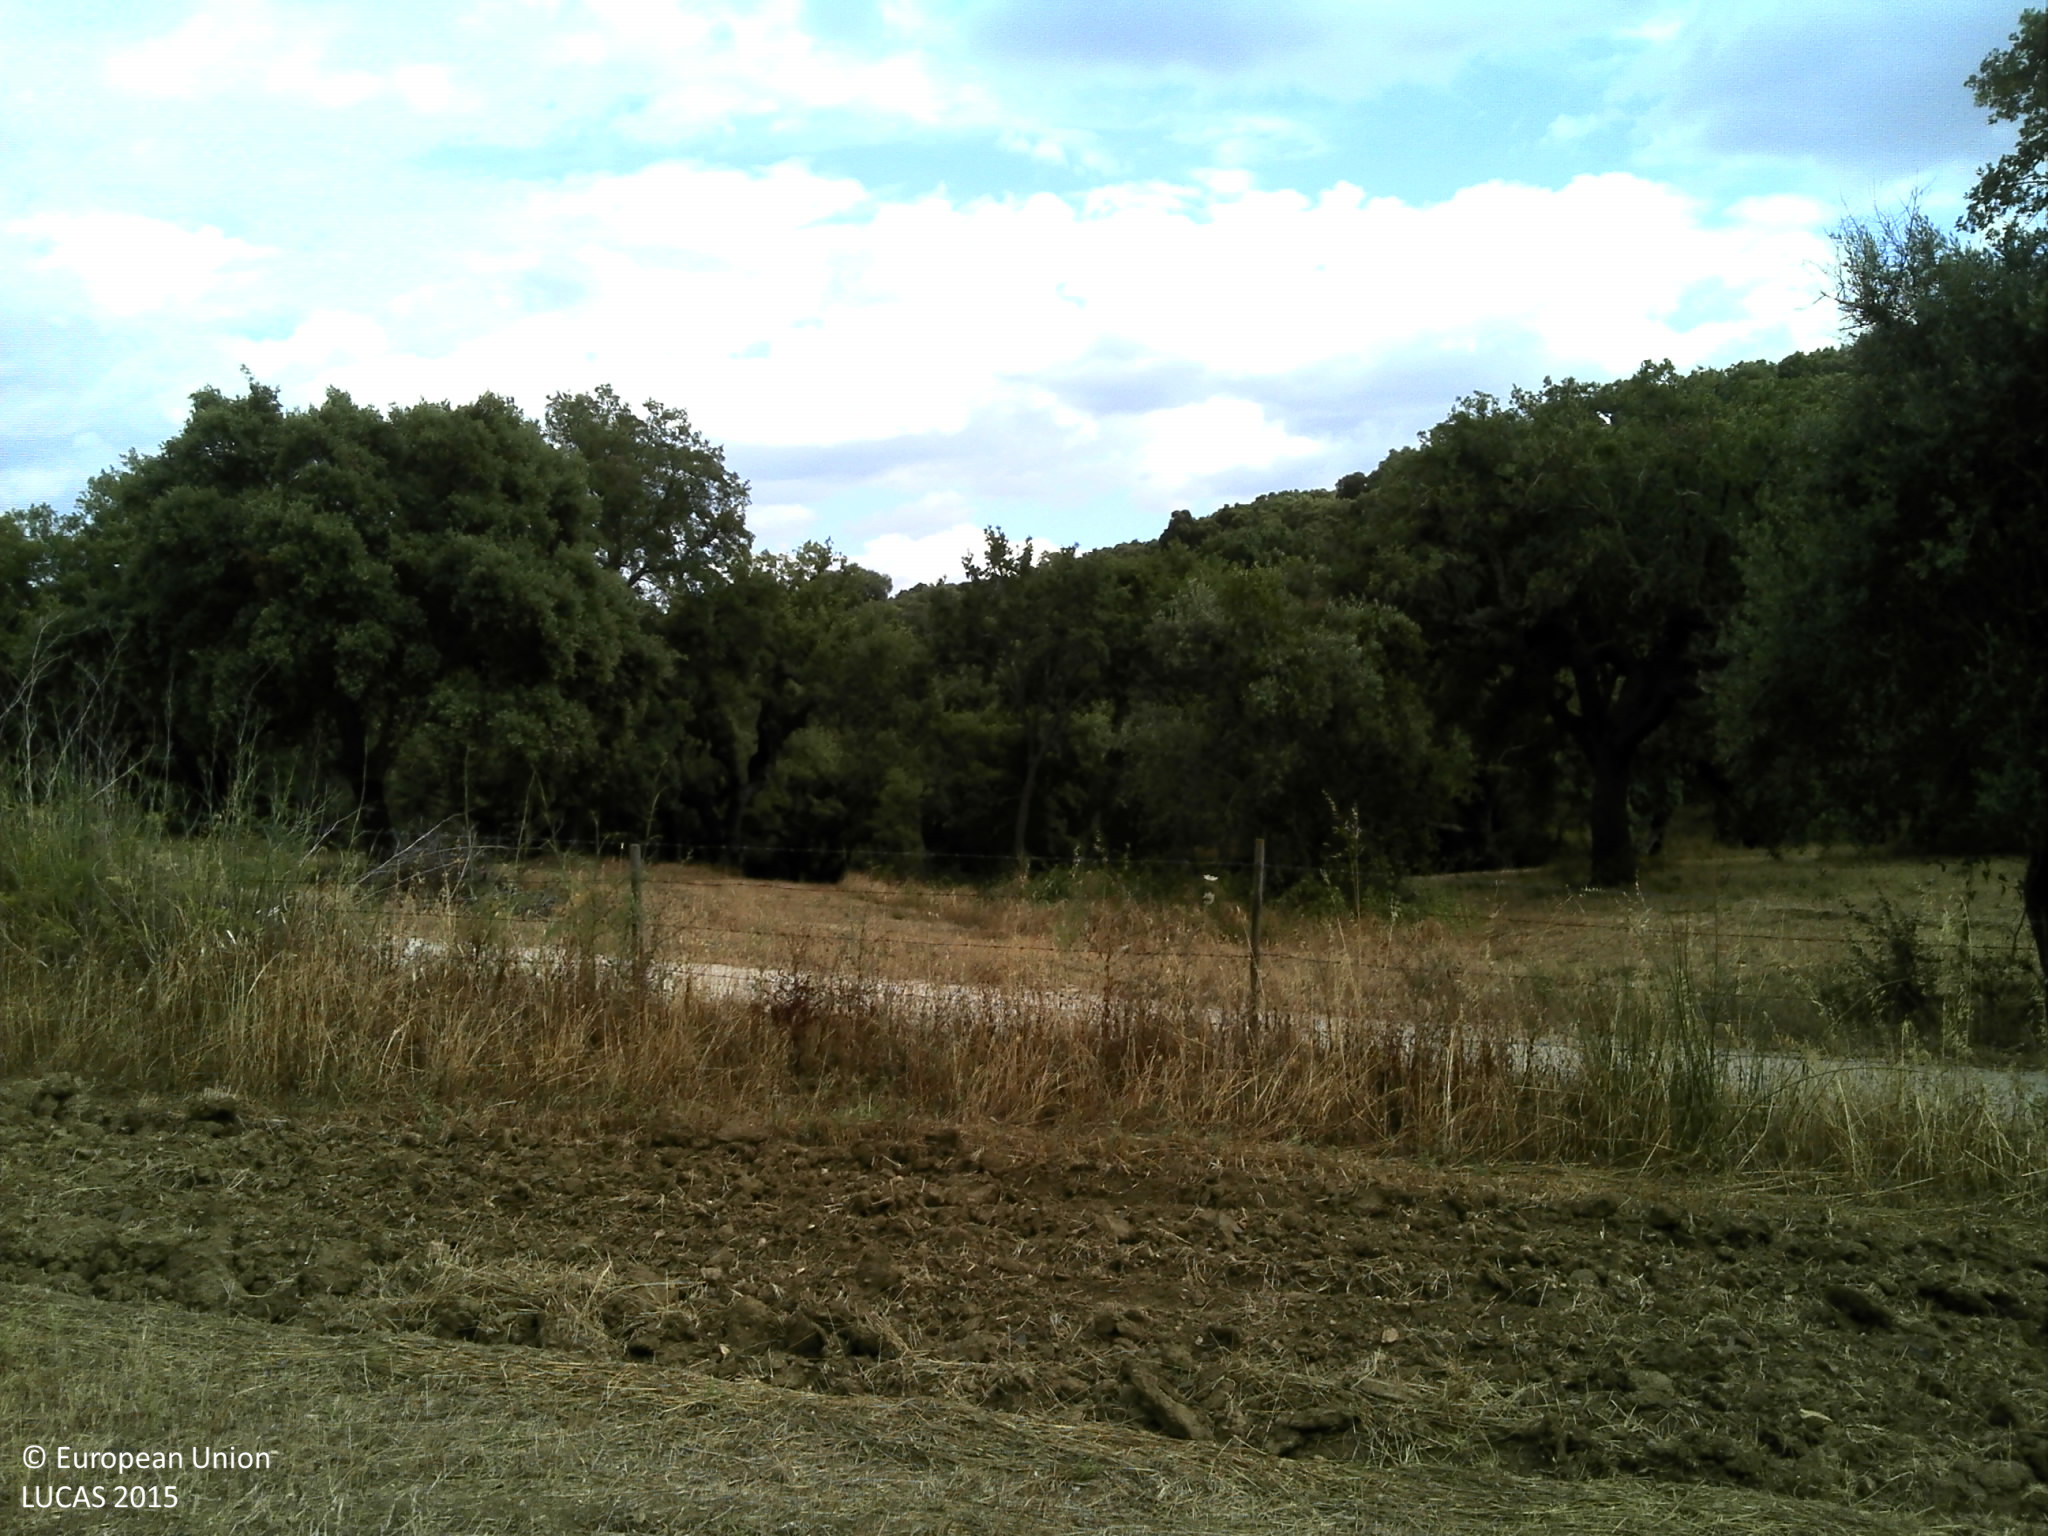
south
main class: Woodland
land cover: Broadleaved woodland
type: broadleaved evergreen forest
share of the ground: 10 - 25 %
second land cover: Other leguminous and mixtures for fodder
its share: < 10 %
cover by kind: unconsolidated bare surface 80 %, broadleaved forest trees 15 %, herbaceous plants 5 %
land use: Forestry
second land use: Agriculture (excluding fallow land and kitchen gardens)
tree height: > 5 m
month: June
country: PT
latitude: 38.5555
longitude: -8.1649
